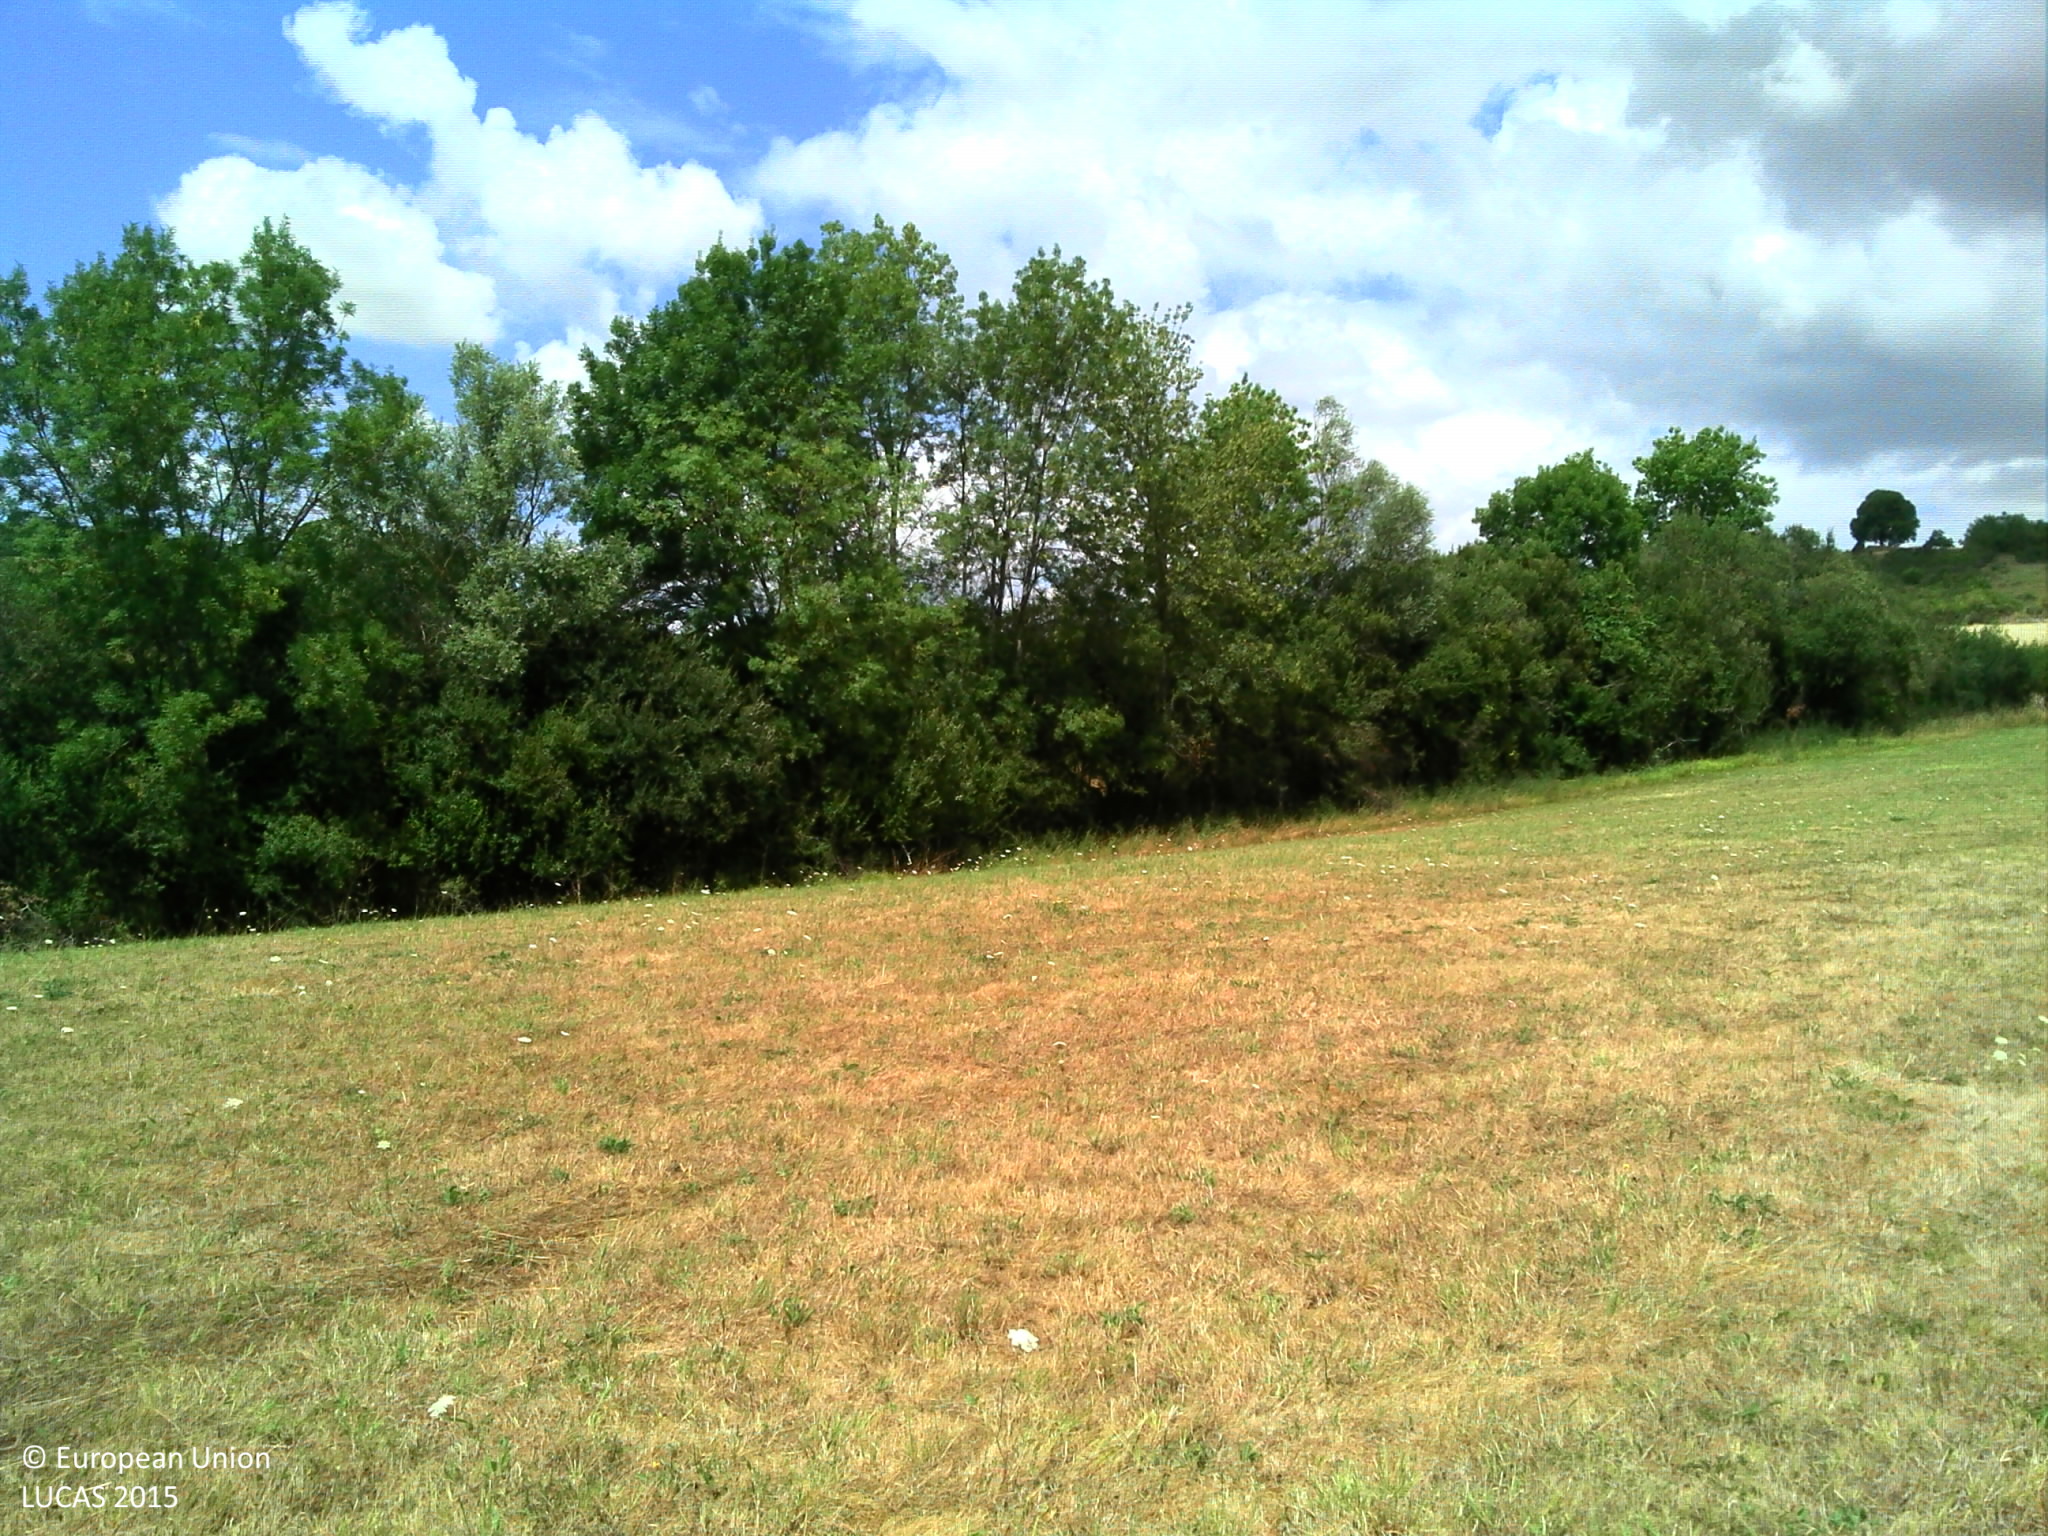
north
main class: Grassland
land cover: Grassland without tree/shrub cover
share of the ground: > 75 %
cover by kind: herbaceous plants 100 %
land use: Agriculture (excluding fallow land and kitchen gardens)
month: July
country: FR
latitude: 44.4833
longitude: 0.5753
